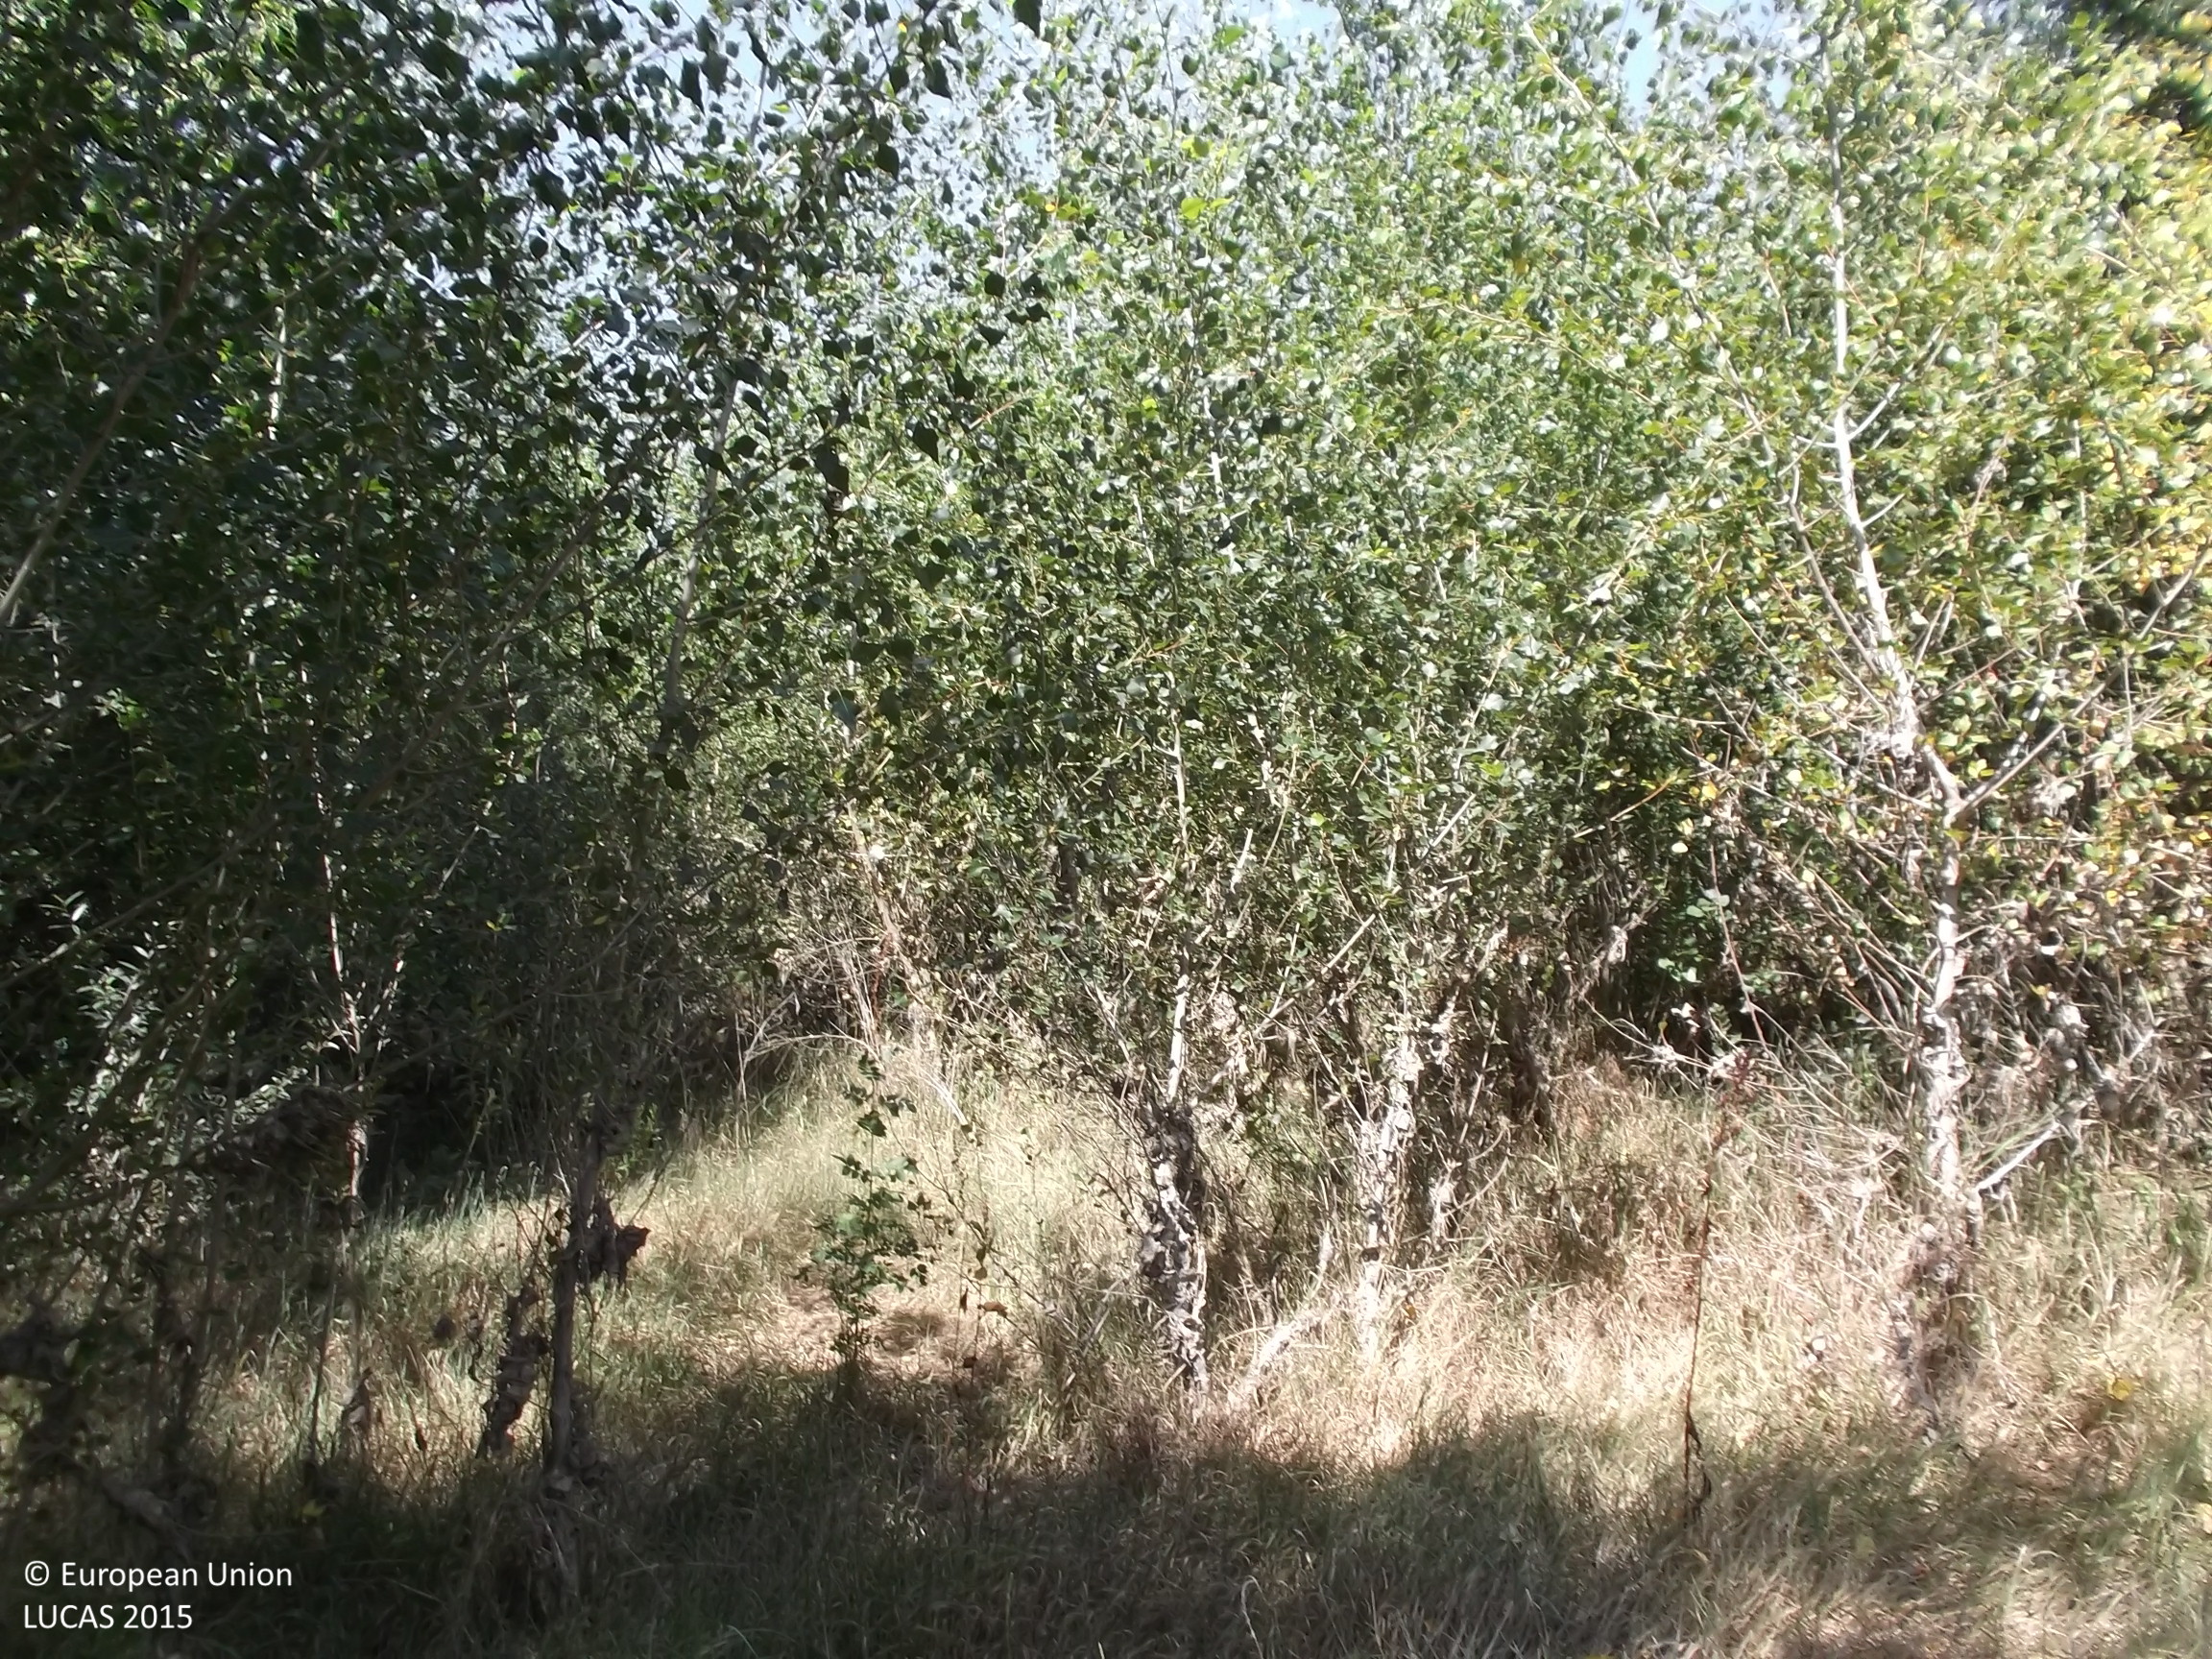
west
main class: Woodland
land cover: Broadleaved woodland
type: floodplain forest
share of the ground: > 75 %
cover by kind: broadleaved forest trees 80 %, herbaceous plants 20 %
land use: Semi-natural and natural areas not in use
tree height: > 5 m
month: July
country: ES
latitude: 42.3437
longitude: -1.6513
